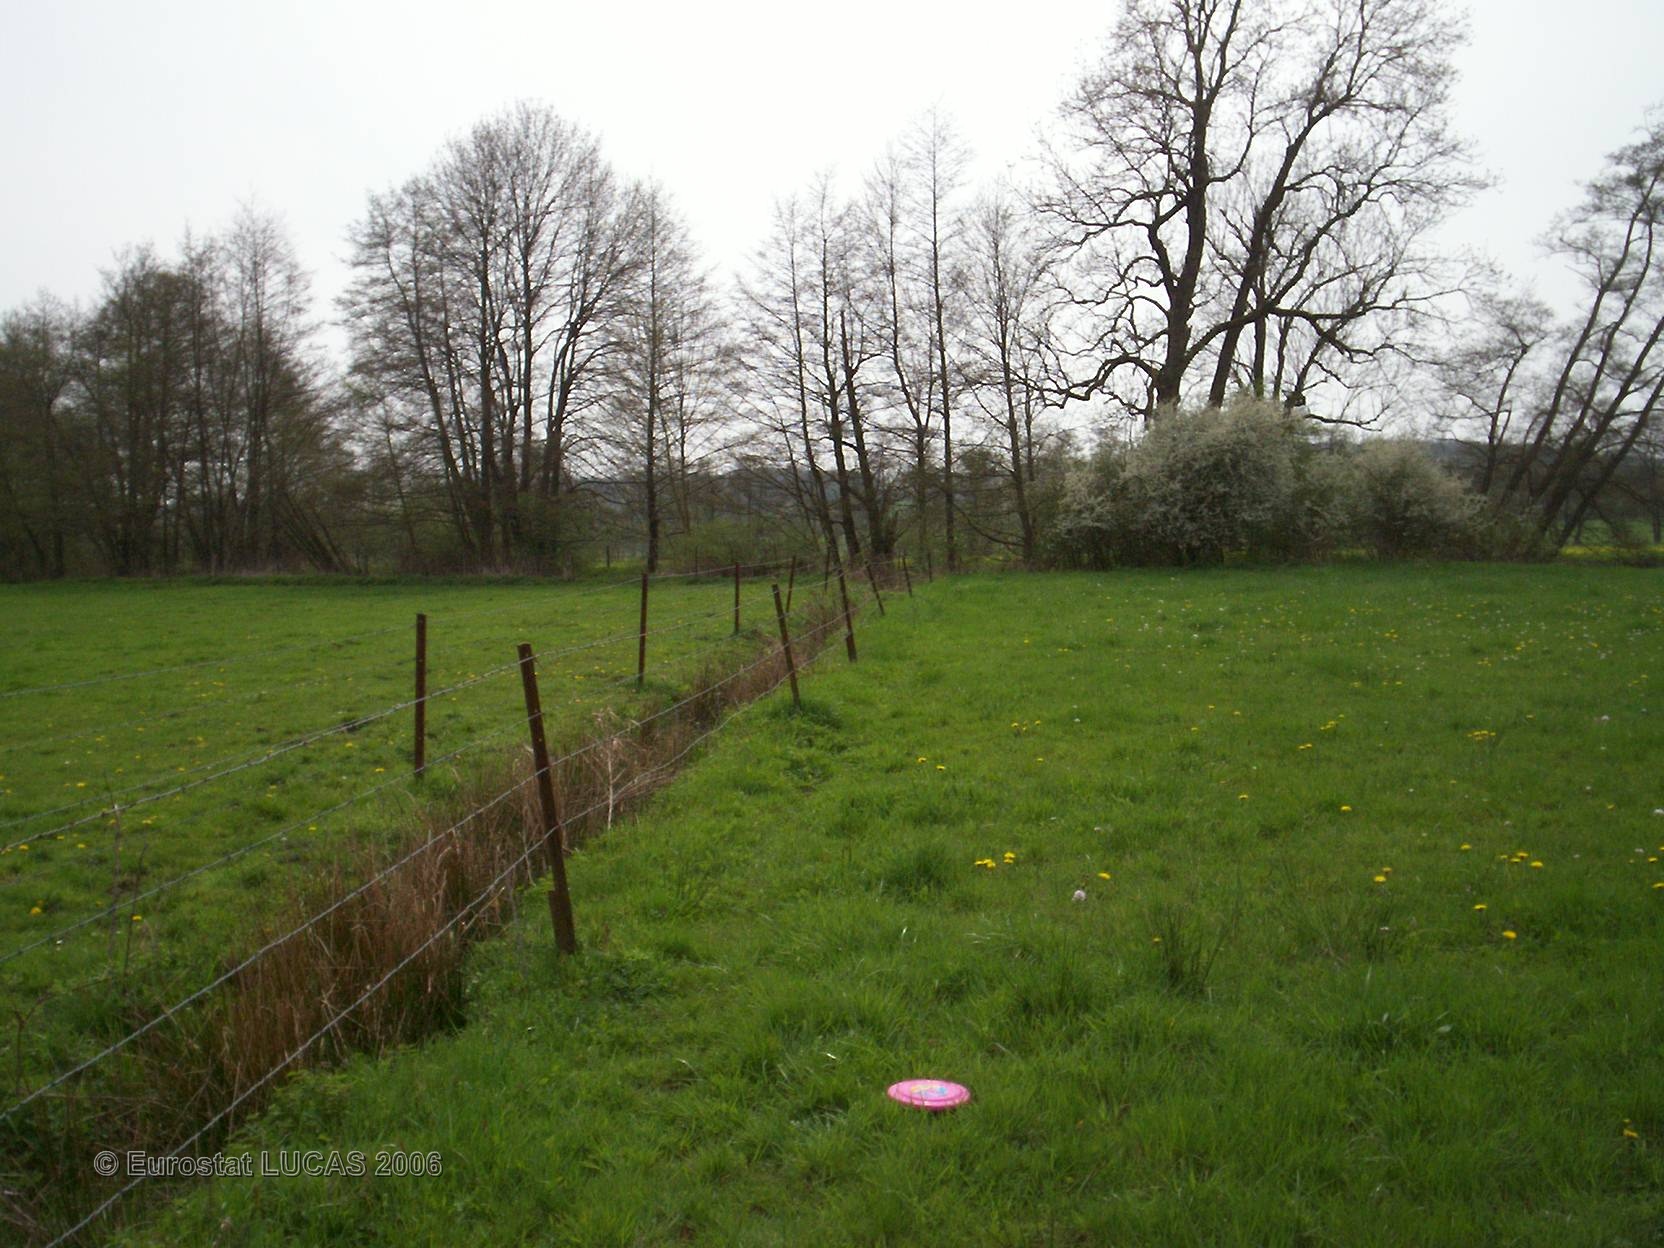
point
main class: Grassland
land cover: Grassland without tree/shrub cover
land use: Agriculture (excluding fallow land and kitchen gardens)
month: May
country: FR
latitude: 49.8659
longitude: 4.3891
